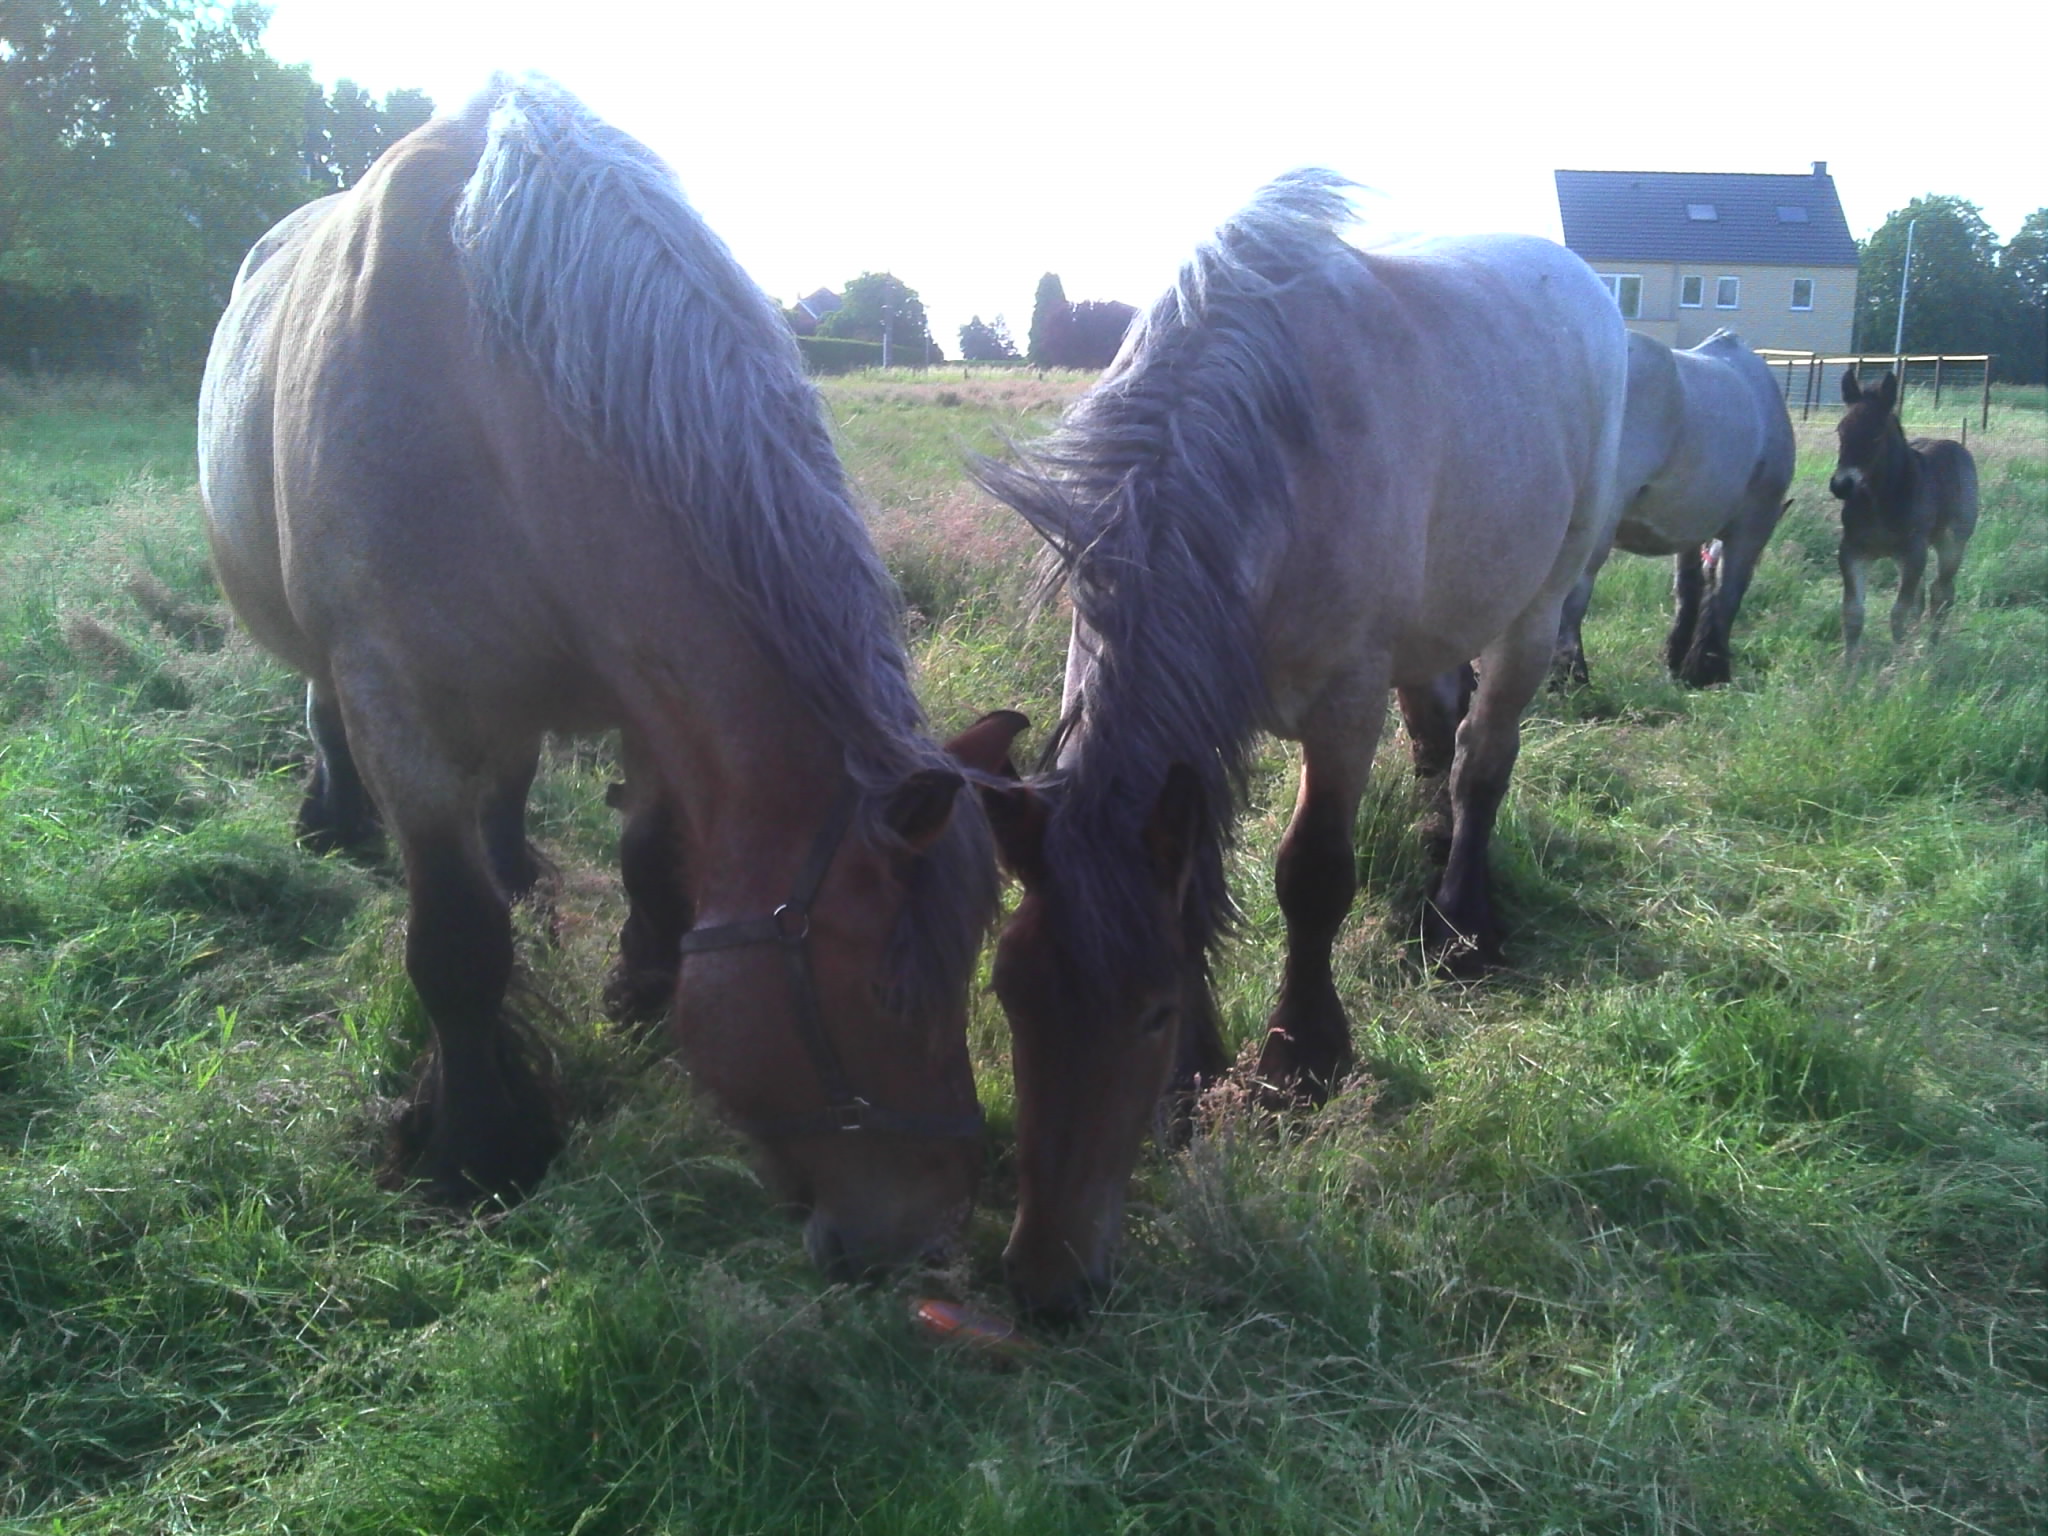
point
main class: Grassland
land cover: Grassland without tree/shrub cover
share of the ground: > 75 %
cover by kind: herbaceous plants 100 %
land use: Agriculture (excluding fallow land and kitchen gardens)
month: June
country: BE
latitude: 50.3903
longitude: 4.8065
